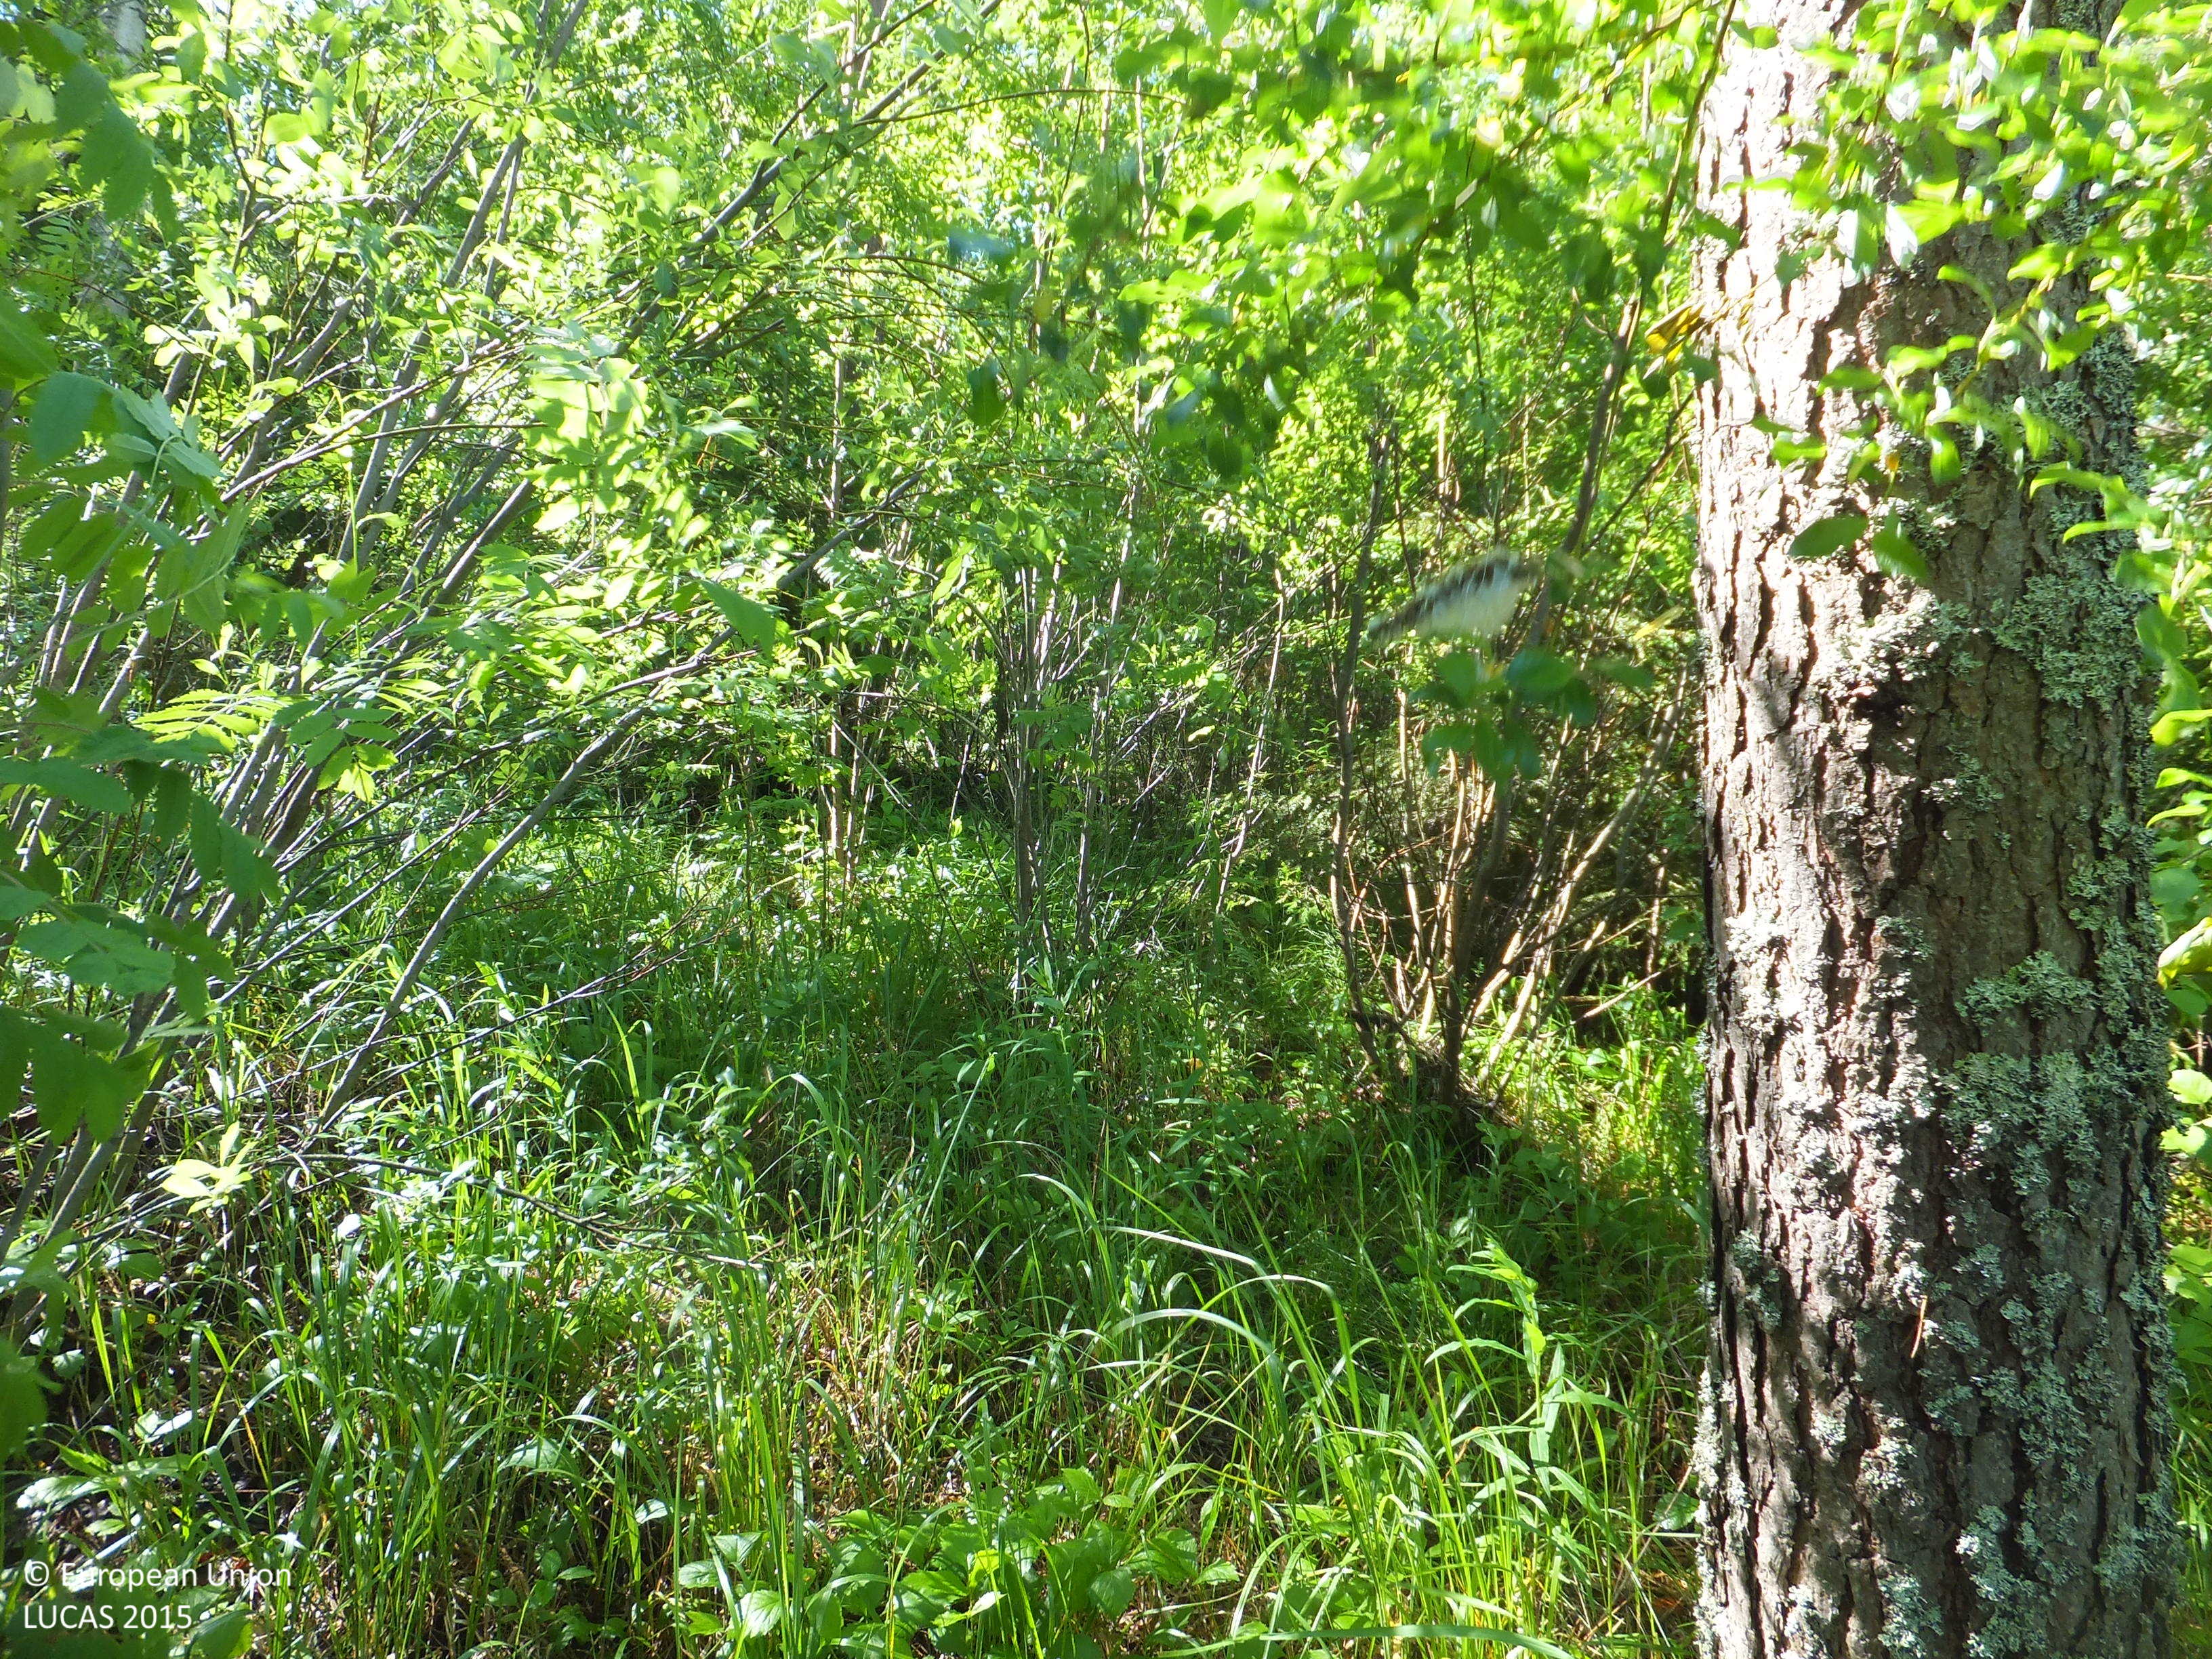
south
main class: Woodland
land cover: Other mixed woodland
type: boreal forest
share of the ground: > 75 %
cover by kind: coniferous forest trees 40 %, broadleaved forest trees 35 %, herbaceous plants 20 %, shrubs 5 %
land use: Forestry
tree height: > 5 m
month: July
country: FI
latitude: 63.1320
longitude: 23.9768
